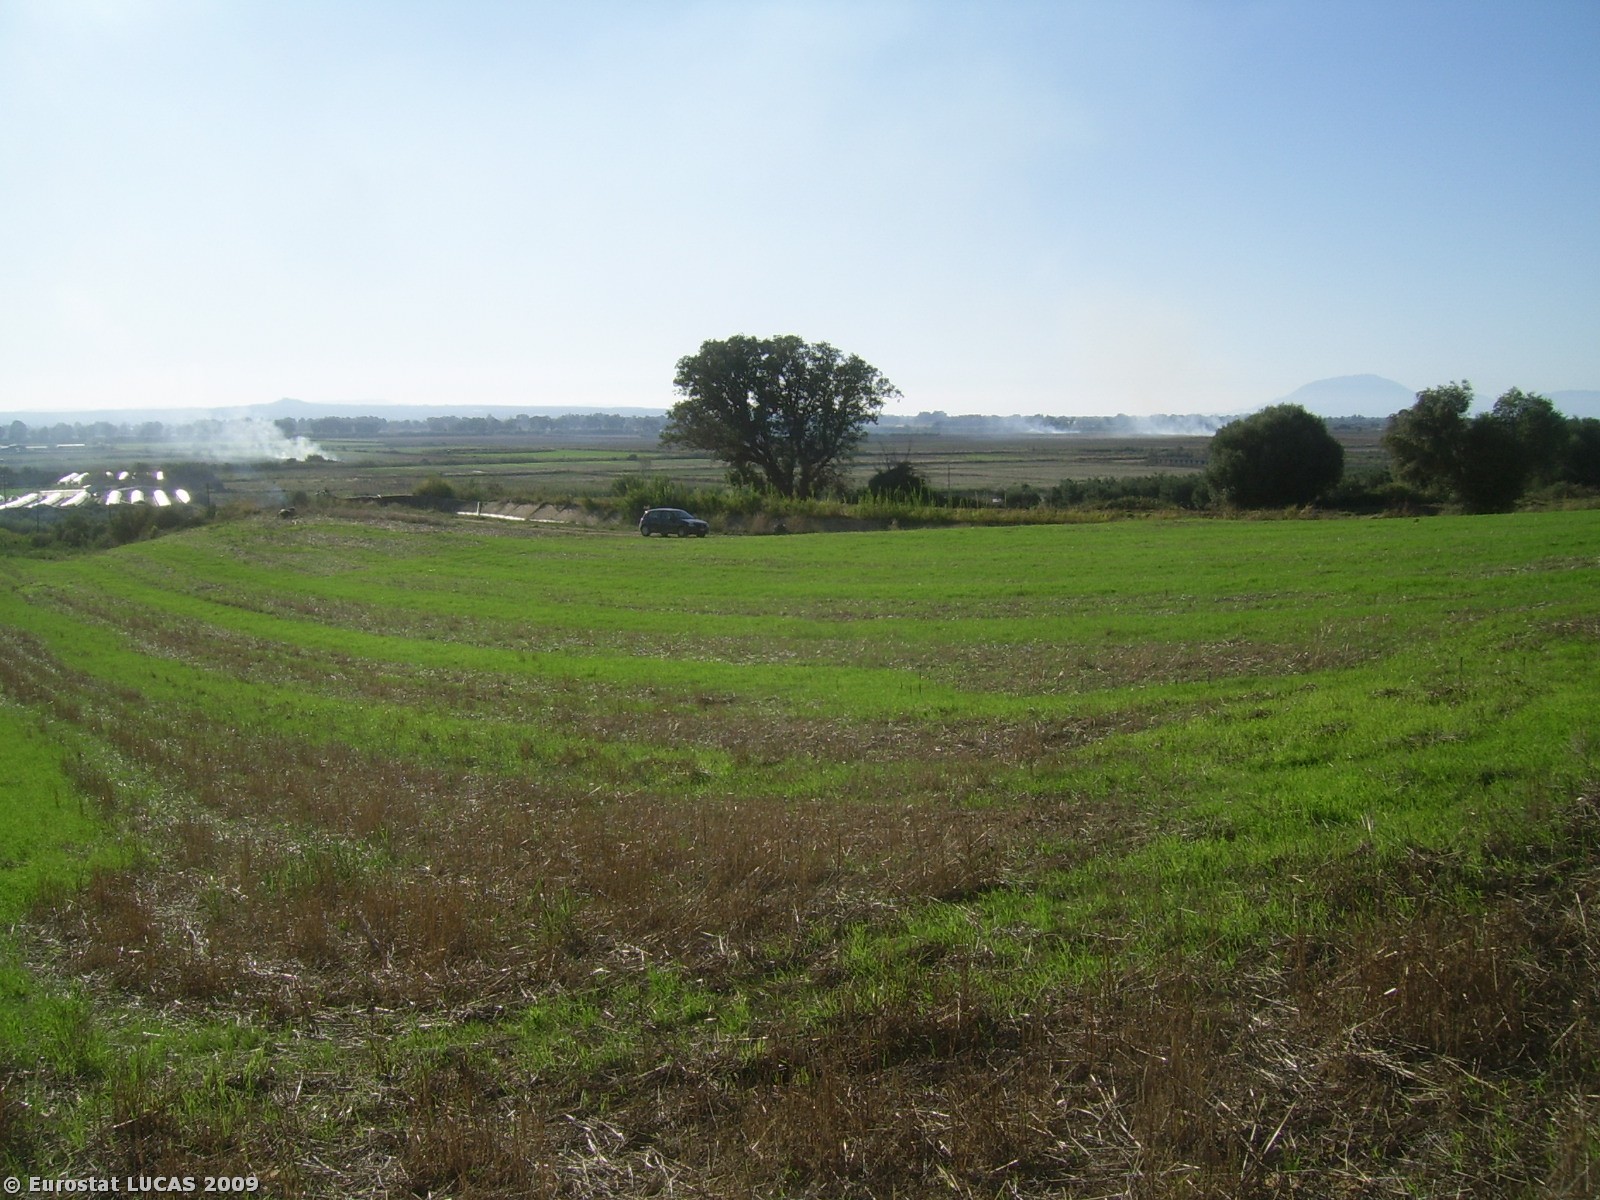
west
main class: Woodland
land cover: Broadleaved woodland
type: hemiboreal forest and nemoral coniferous forest and mixed broadleaved-coniferous forest
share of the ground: > 75 %
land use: Forestry
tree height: > 5 m
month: October
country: GR
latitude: 37.9283
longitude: 21.3268
